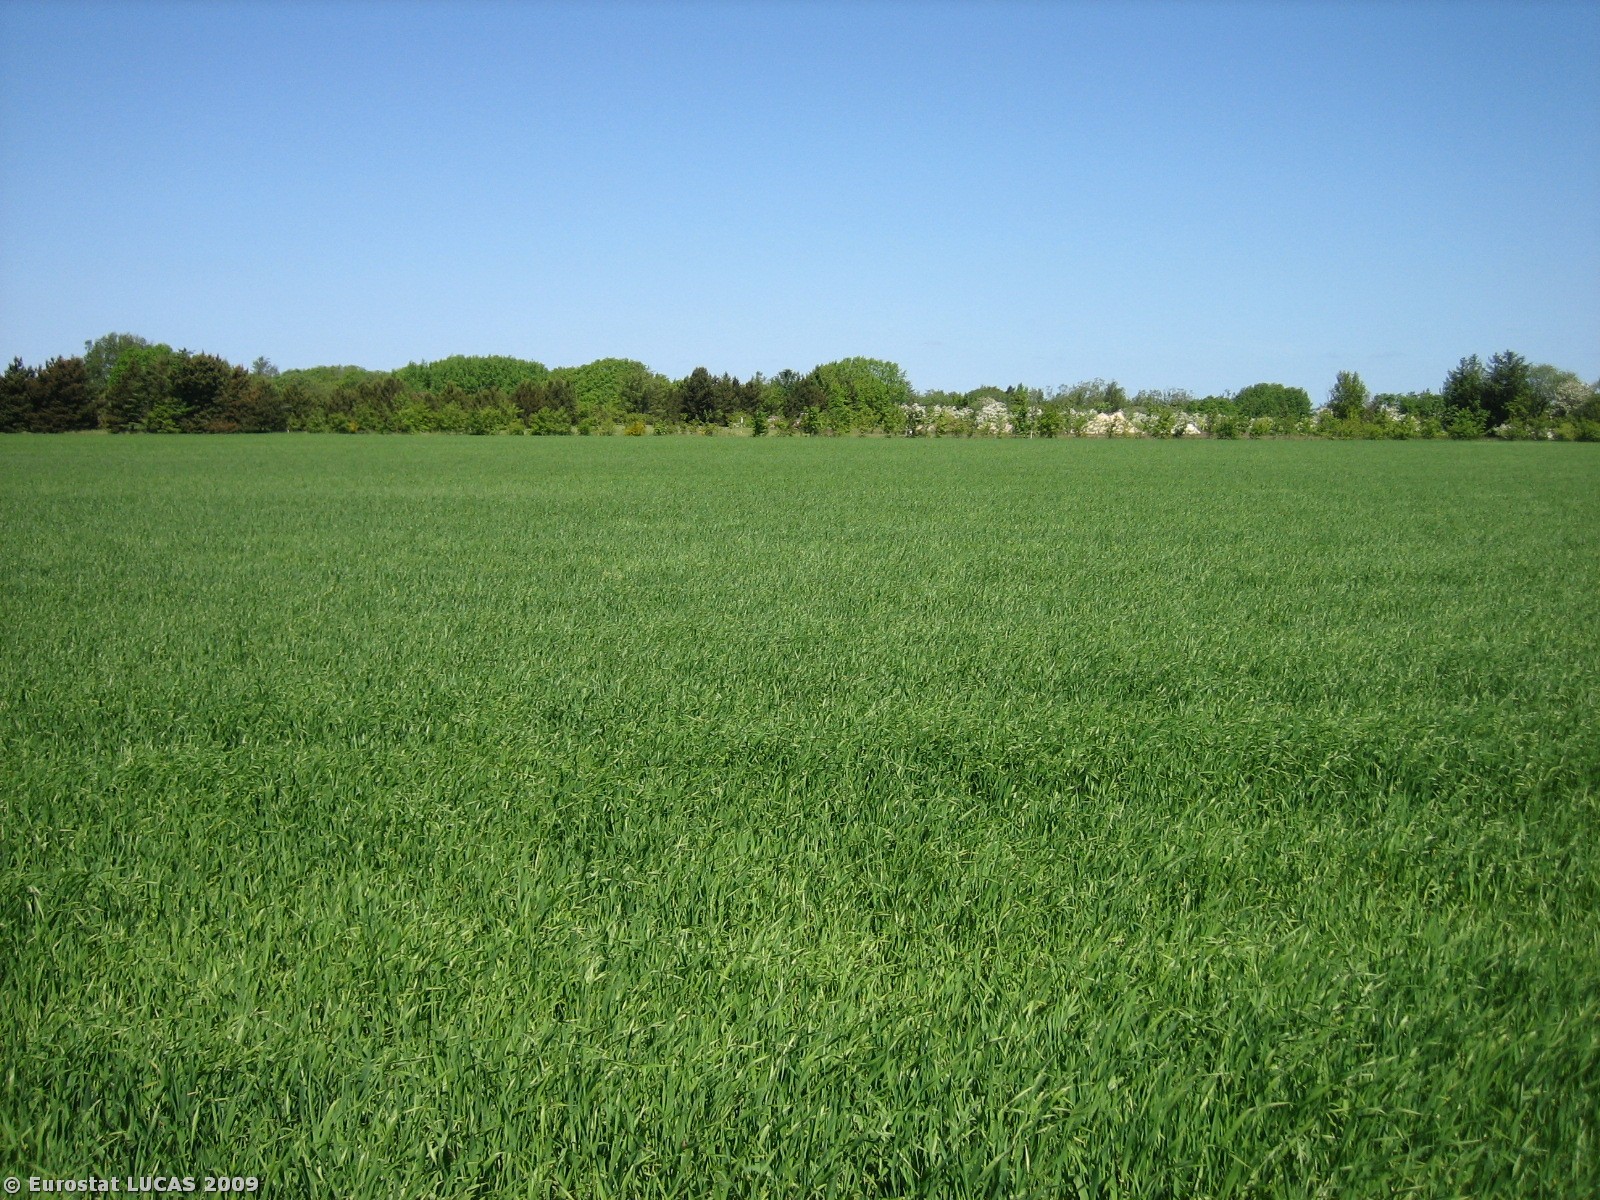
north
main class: Cropland
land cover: Barley
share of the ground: > 75 %
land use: Agriculture (excluding fallow land and kitchen gardens)
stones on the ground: < 10 %
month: May
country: DK
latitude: 55.9305
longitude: 8.8008
